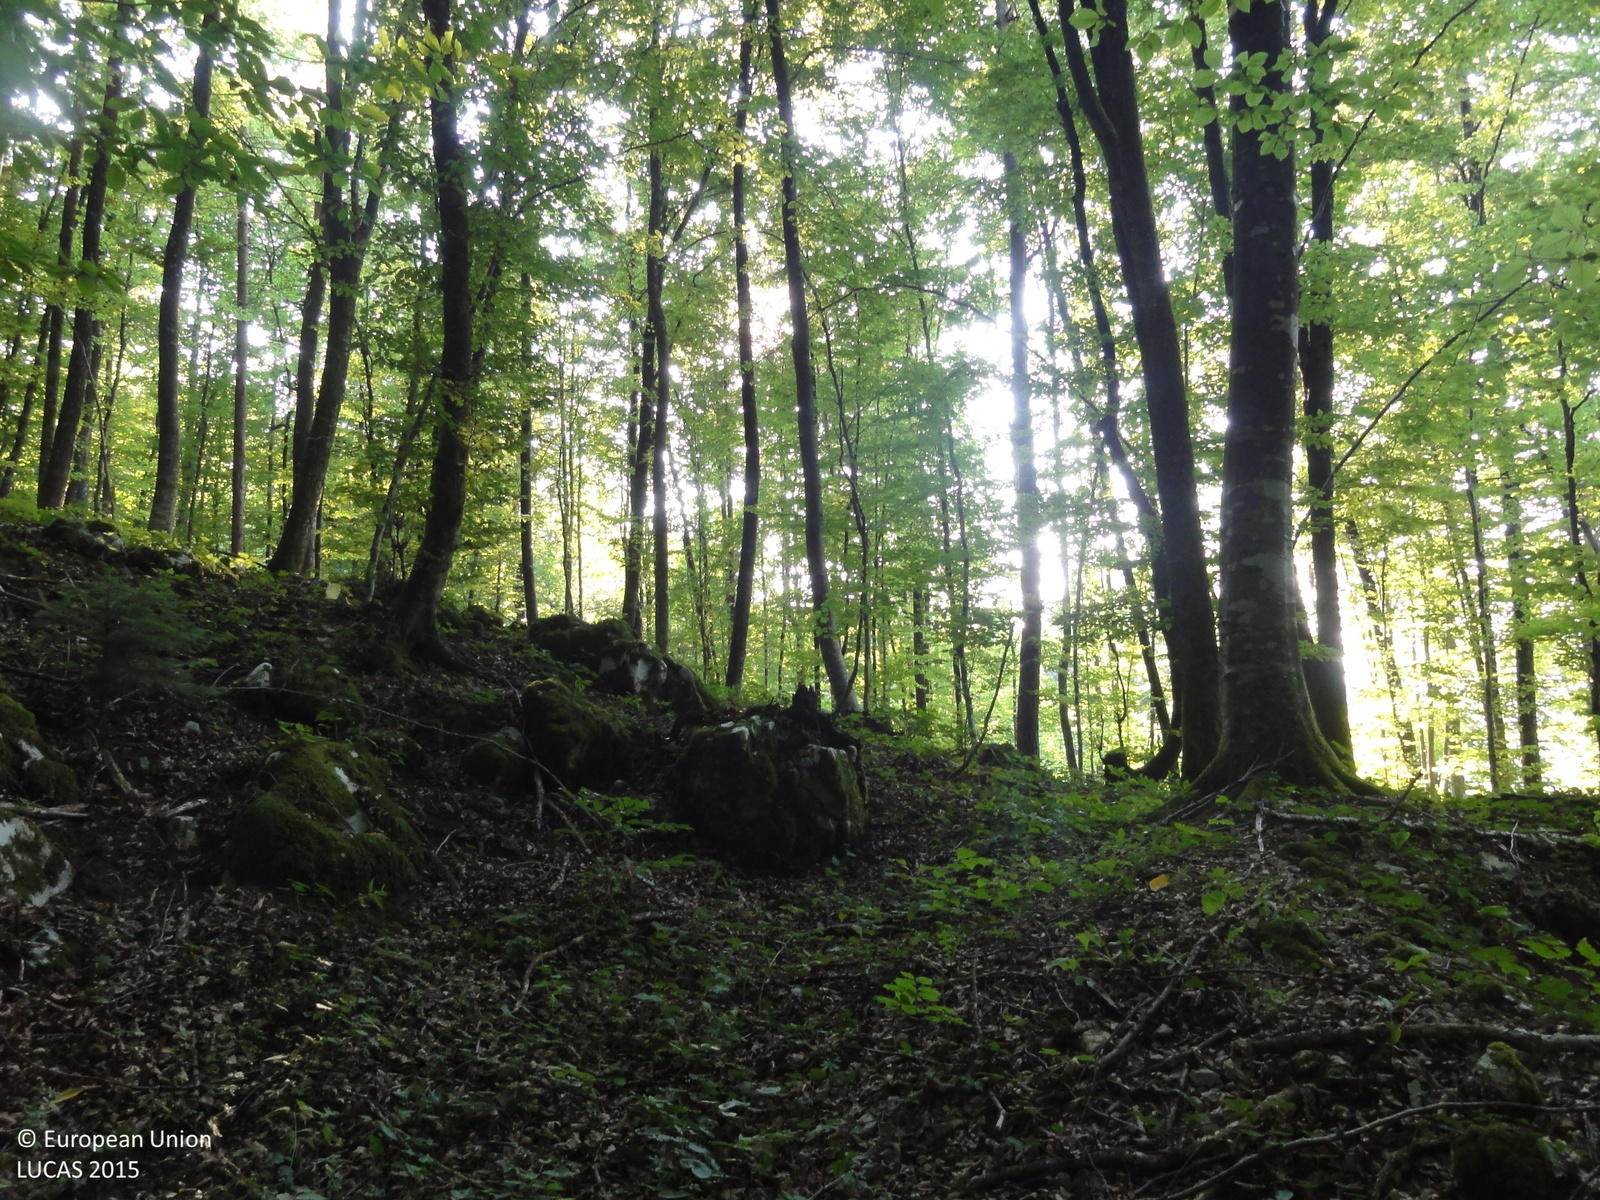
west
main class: Woodland
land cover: Broadleaved woodland
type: beech forest
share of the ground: > 75 %
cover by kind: broadleaved forest trees 95 %, coniferous forest trees 5 %
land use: Forestry
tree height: > 5 m
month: August
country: SI
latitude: 45.8370
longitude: 15.0047
